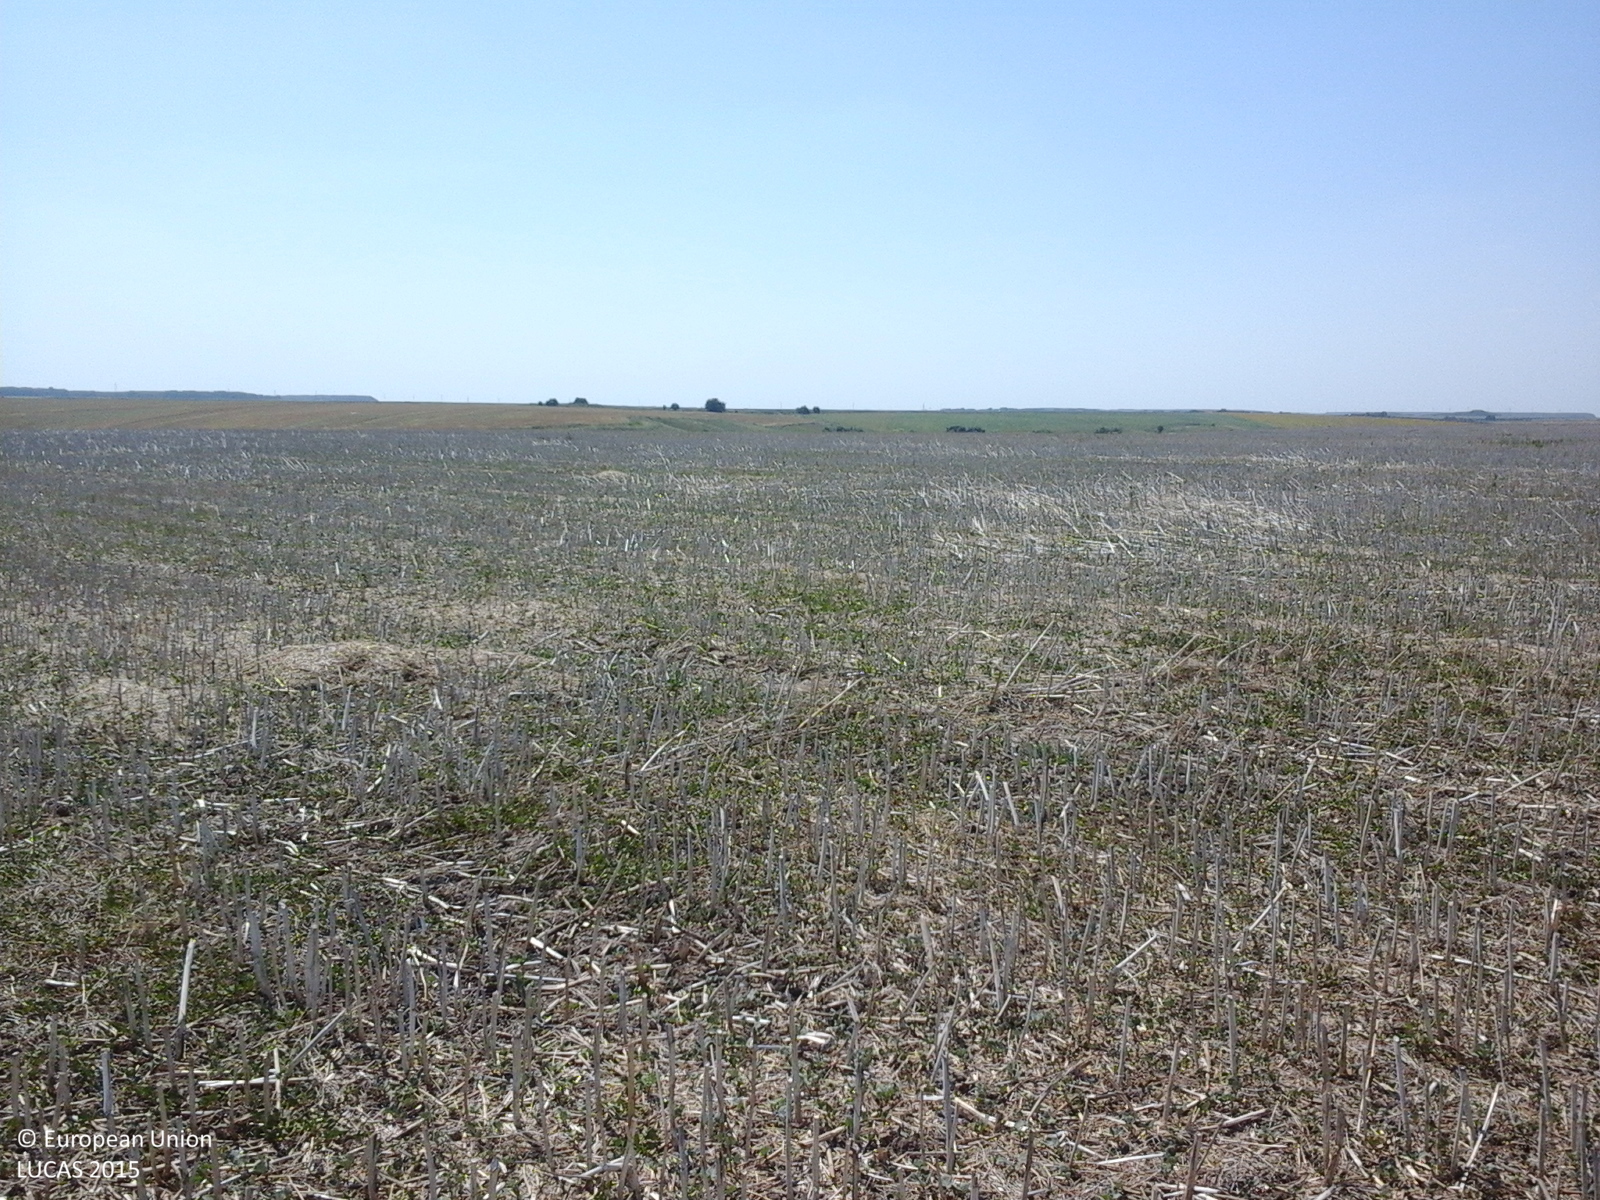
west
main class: Cropland
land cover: Rape and turnip rape
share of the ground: 25 - 50 %
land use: Agriculture (excluding fallow land and kitchen gardens)
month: July
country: RO
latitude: 44.3774
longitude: 26.6217
